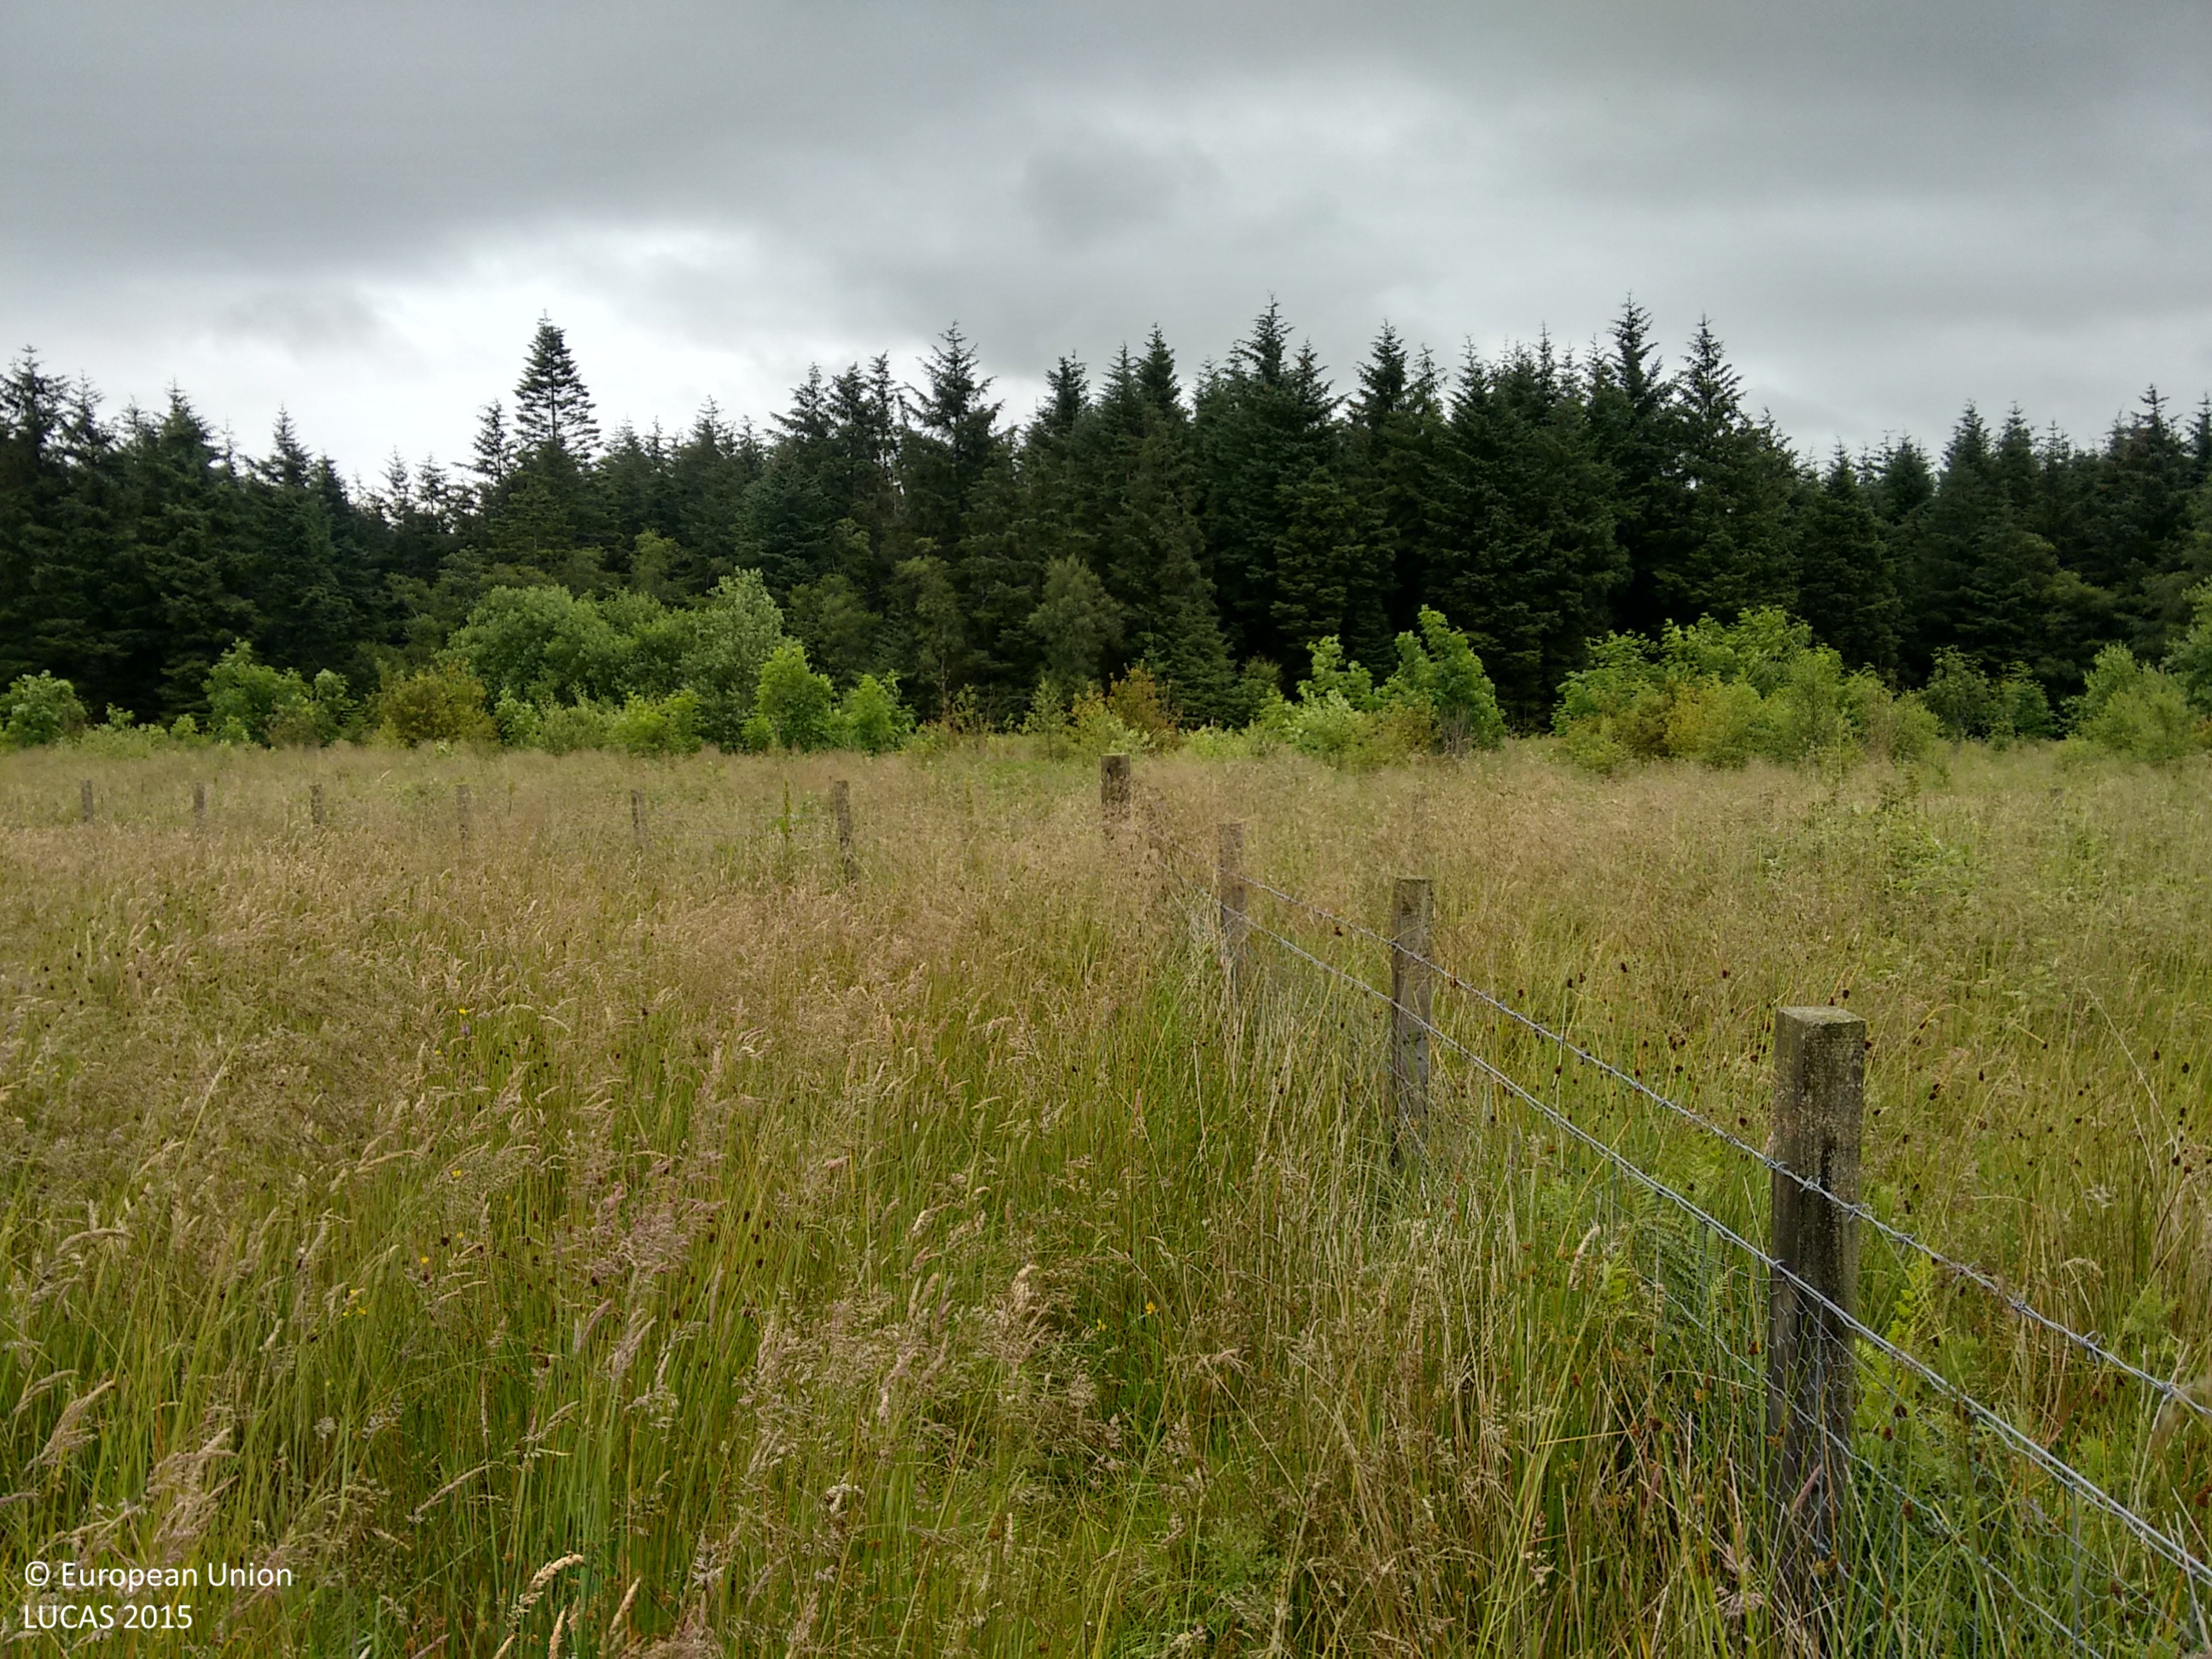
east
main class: Grassland
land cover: Grassland without tree/shrub cover
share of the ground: > 75 %
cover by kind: herbaceous plants 100 %
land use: Agriculture (excluding fallow land and kitchen gardens)
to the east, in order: Grassland without tree/shrub cover; Fences; Grassland without tree/shrub cover; Broadleaved woodland; Ditches and canals; Tracks; Ditches and canals; Grassland without tree/shrub cover; Spruce dominated coniferous woodland
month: July
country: GB
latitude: 56.1363
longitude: -3.4148
